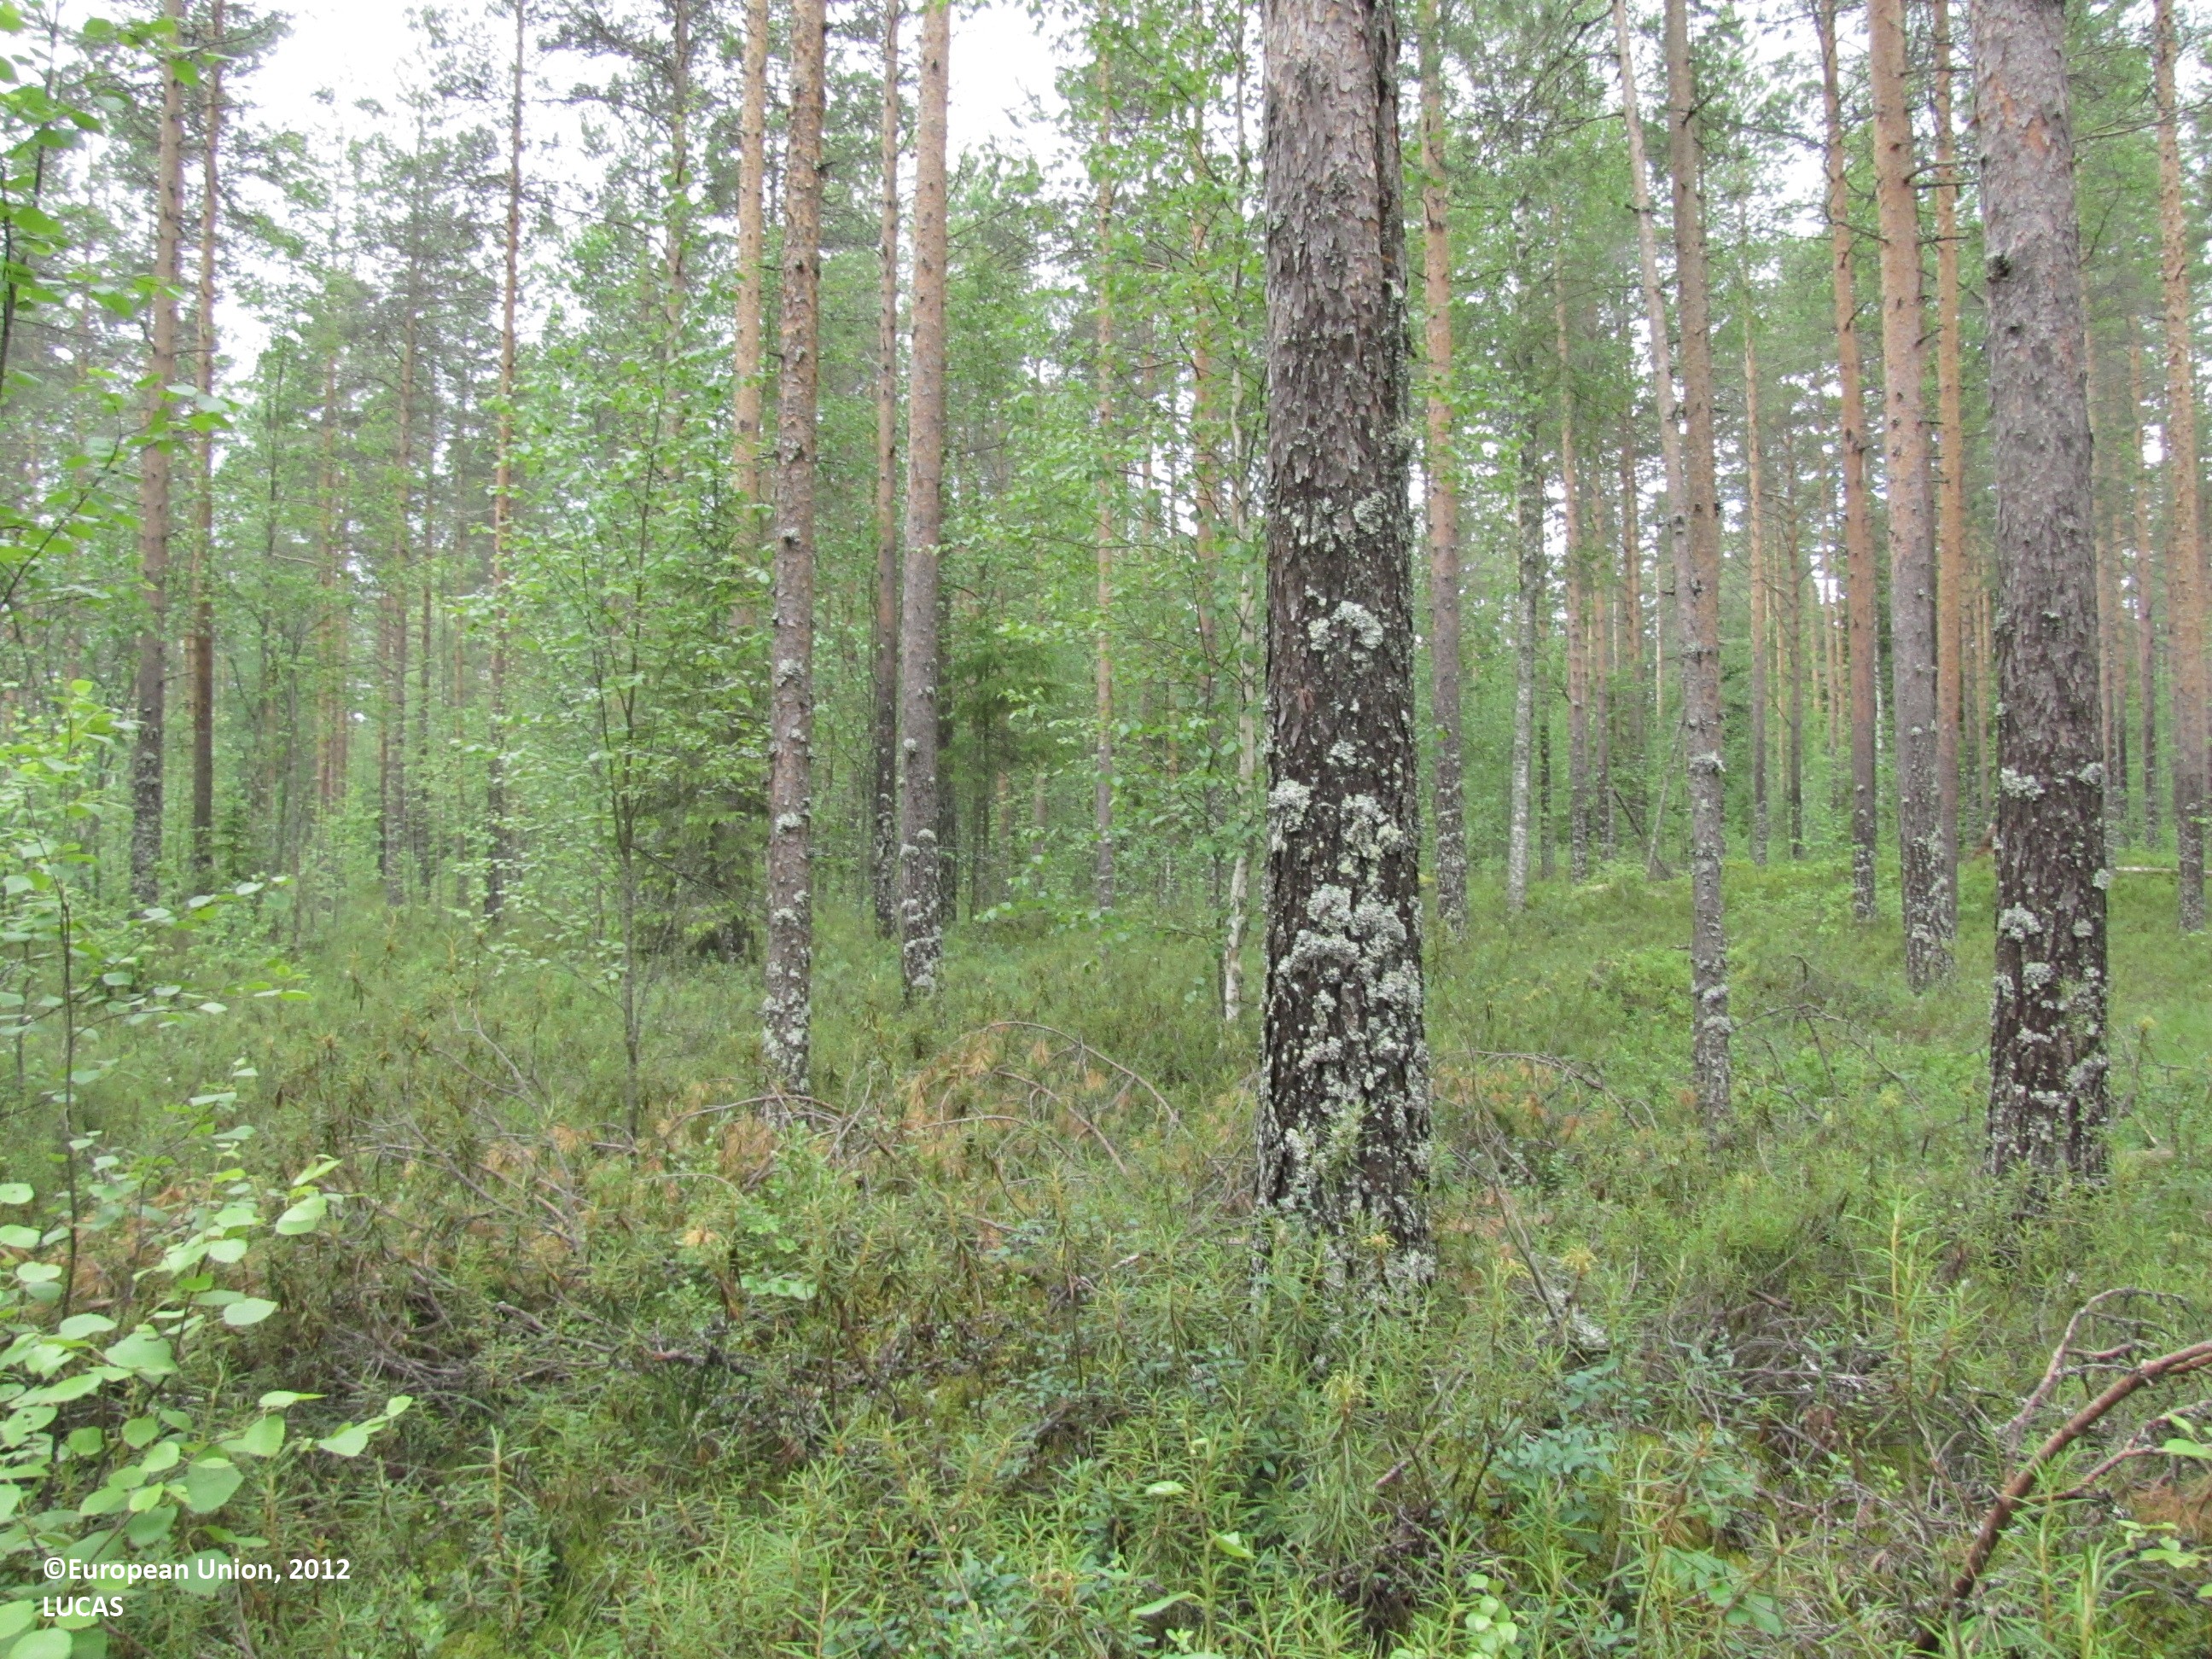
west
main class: Woodland
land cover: Pine dominated coniferous woodland
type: mire and swamp forests
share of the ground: > 75 %
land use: Community services
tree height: > 5 m
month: July
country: FI
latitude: 62.3464
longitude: 23.9277
